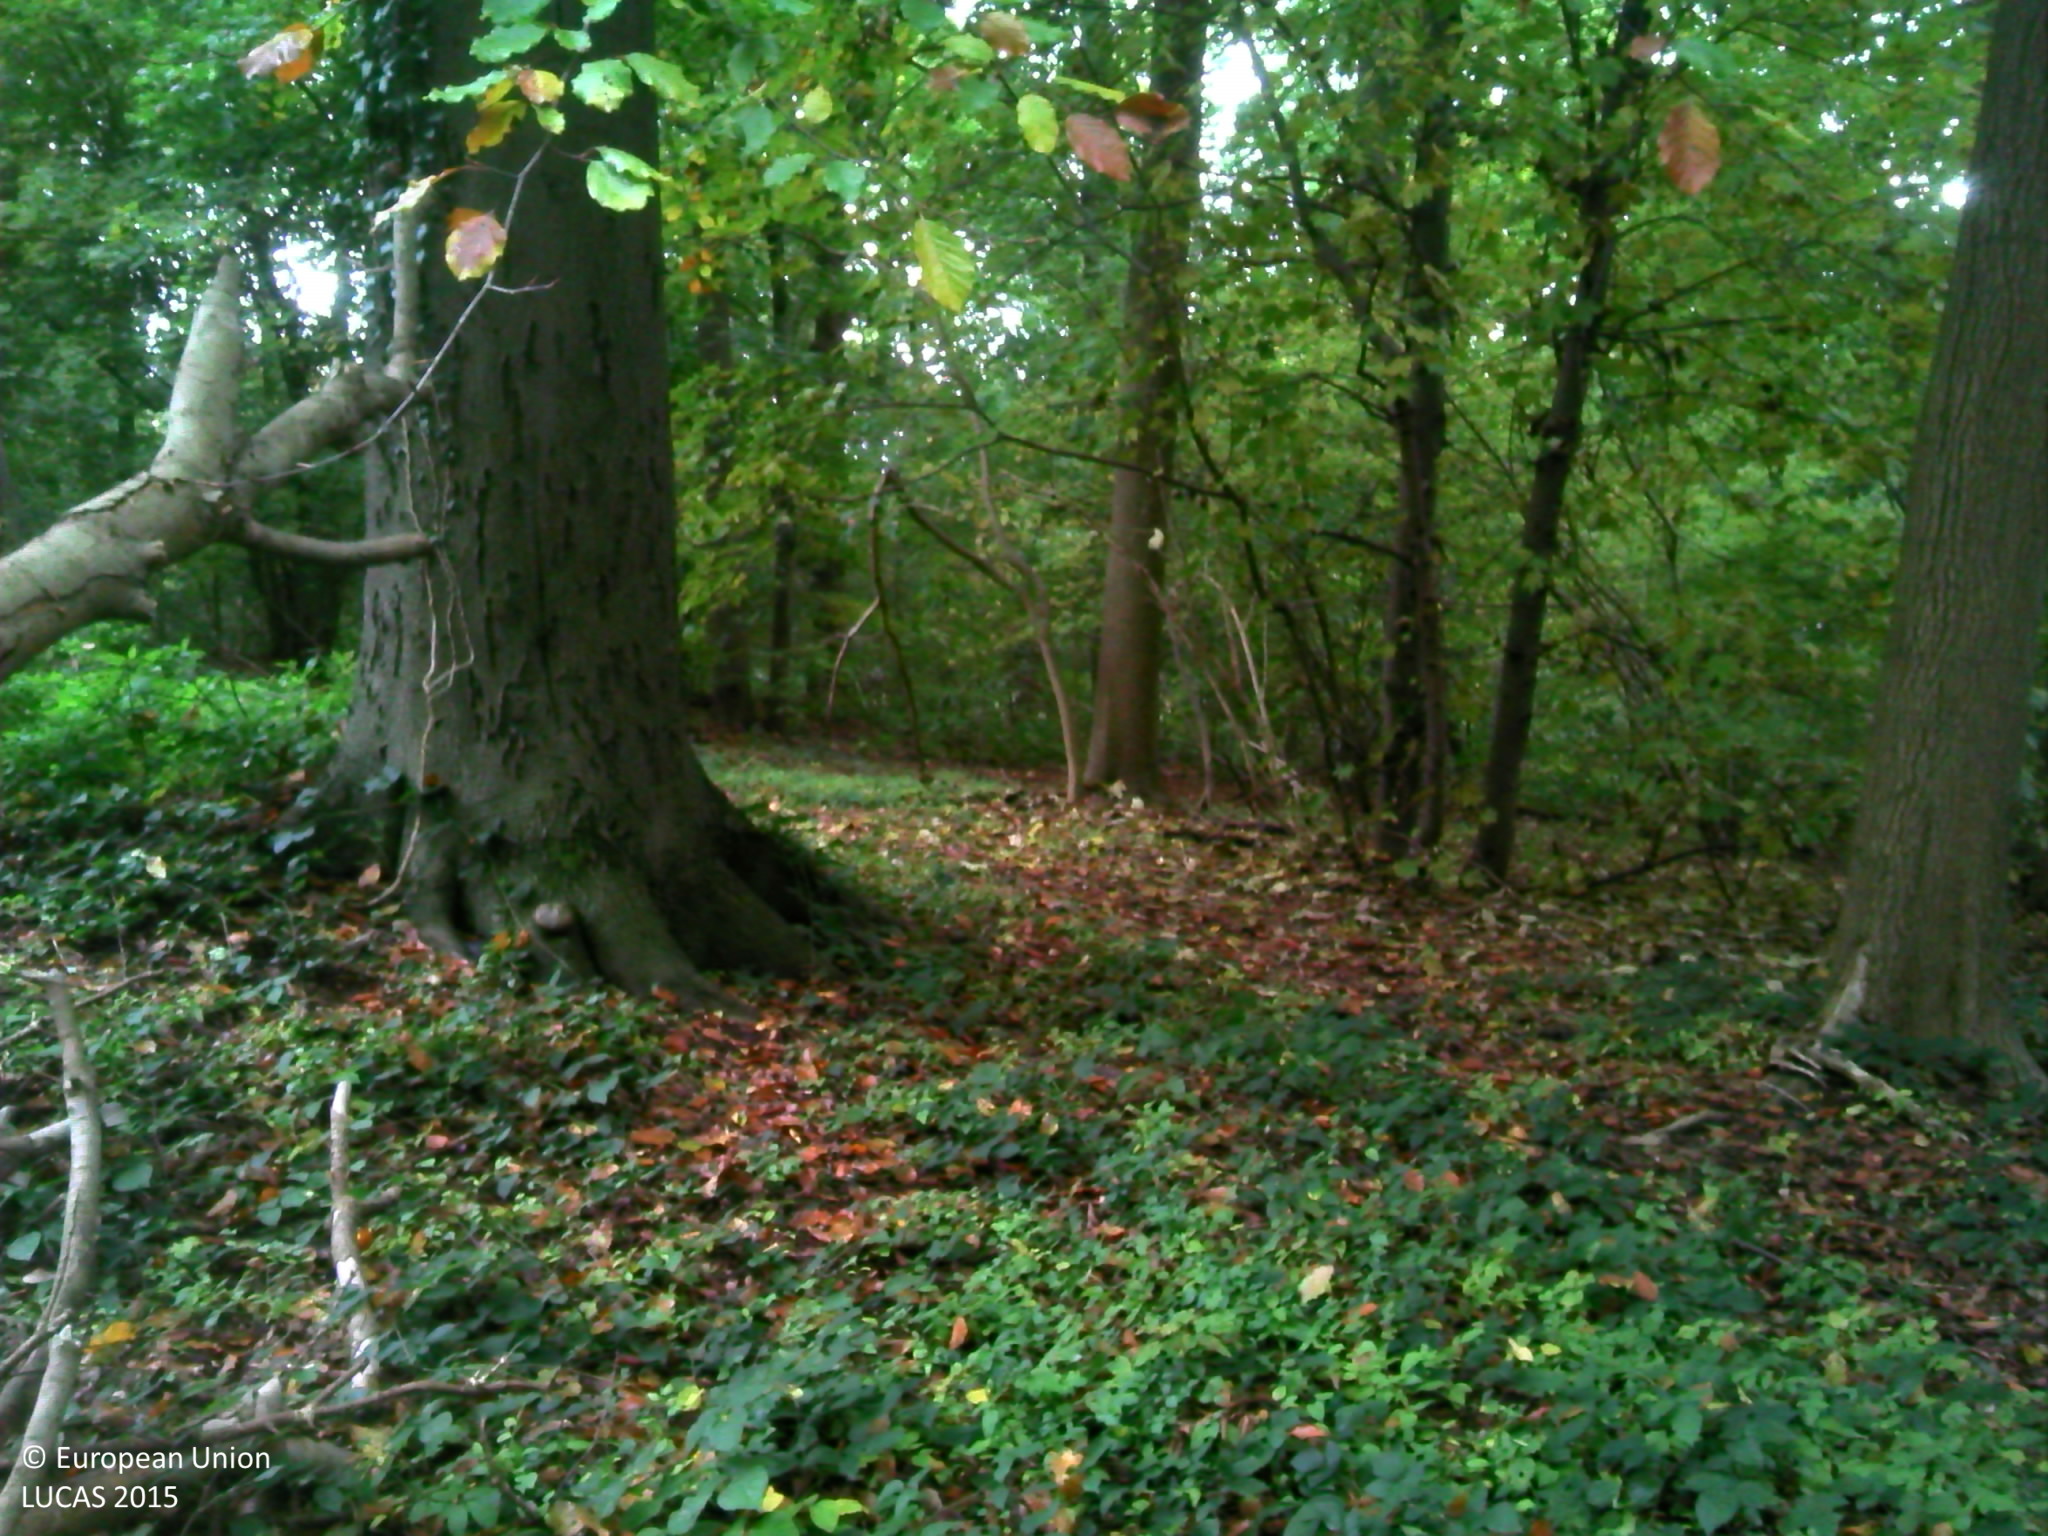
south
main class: Woodland
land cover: Broadleaved woodland
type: mesophytic deciduous forest
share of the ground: > 75 %
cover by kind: broadleaved forest trees 60 %, herbaceous plants 30 %, shrubs 10 %
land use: Forestry
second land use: Amenities, museums, leisure
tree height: > 5 m
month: October
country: BE
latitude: 50.8886
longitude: 4.2947
